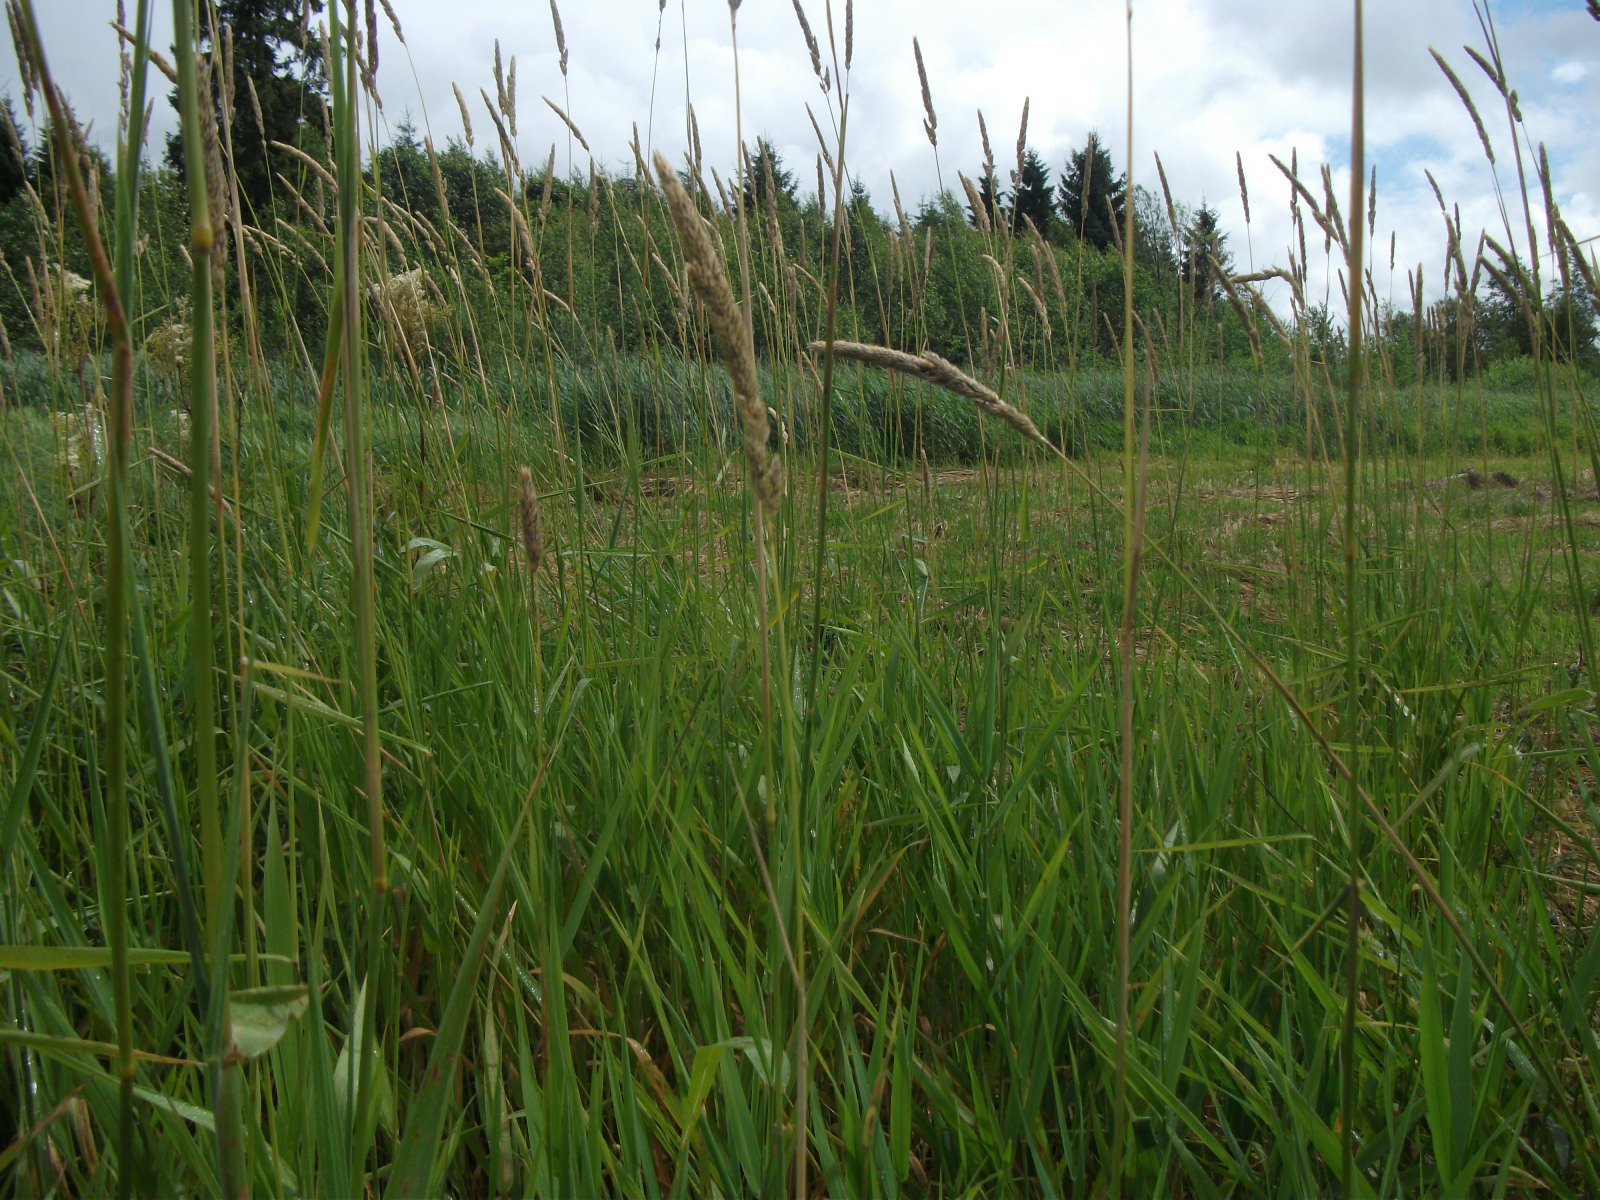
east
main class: Grassland
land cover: Grassland without tree/shrub cover
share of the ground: > 75 %
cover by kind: herbaceous plants 100 %
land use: Agriculture (excluding fallow land and kitchen gardens)
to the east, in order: Grassland without tree/shrub cover; Ditches and canals; Abandoned hedges; Grassland without tree/shrub cover; Ditches and canals; Grassland with sparse tree/shrub cover; Other mixed woodland; Broadleaved woodland
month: July
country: LV
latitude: 57.0078
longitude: 25.8860
